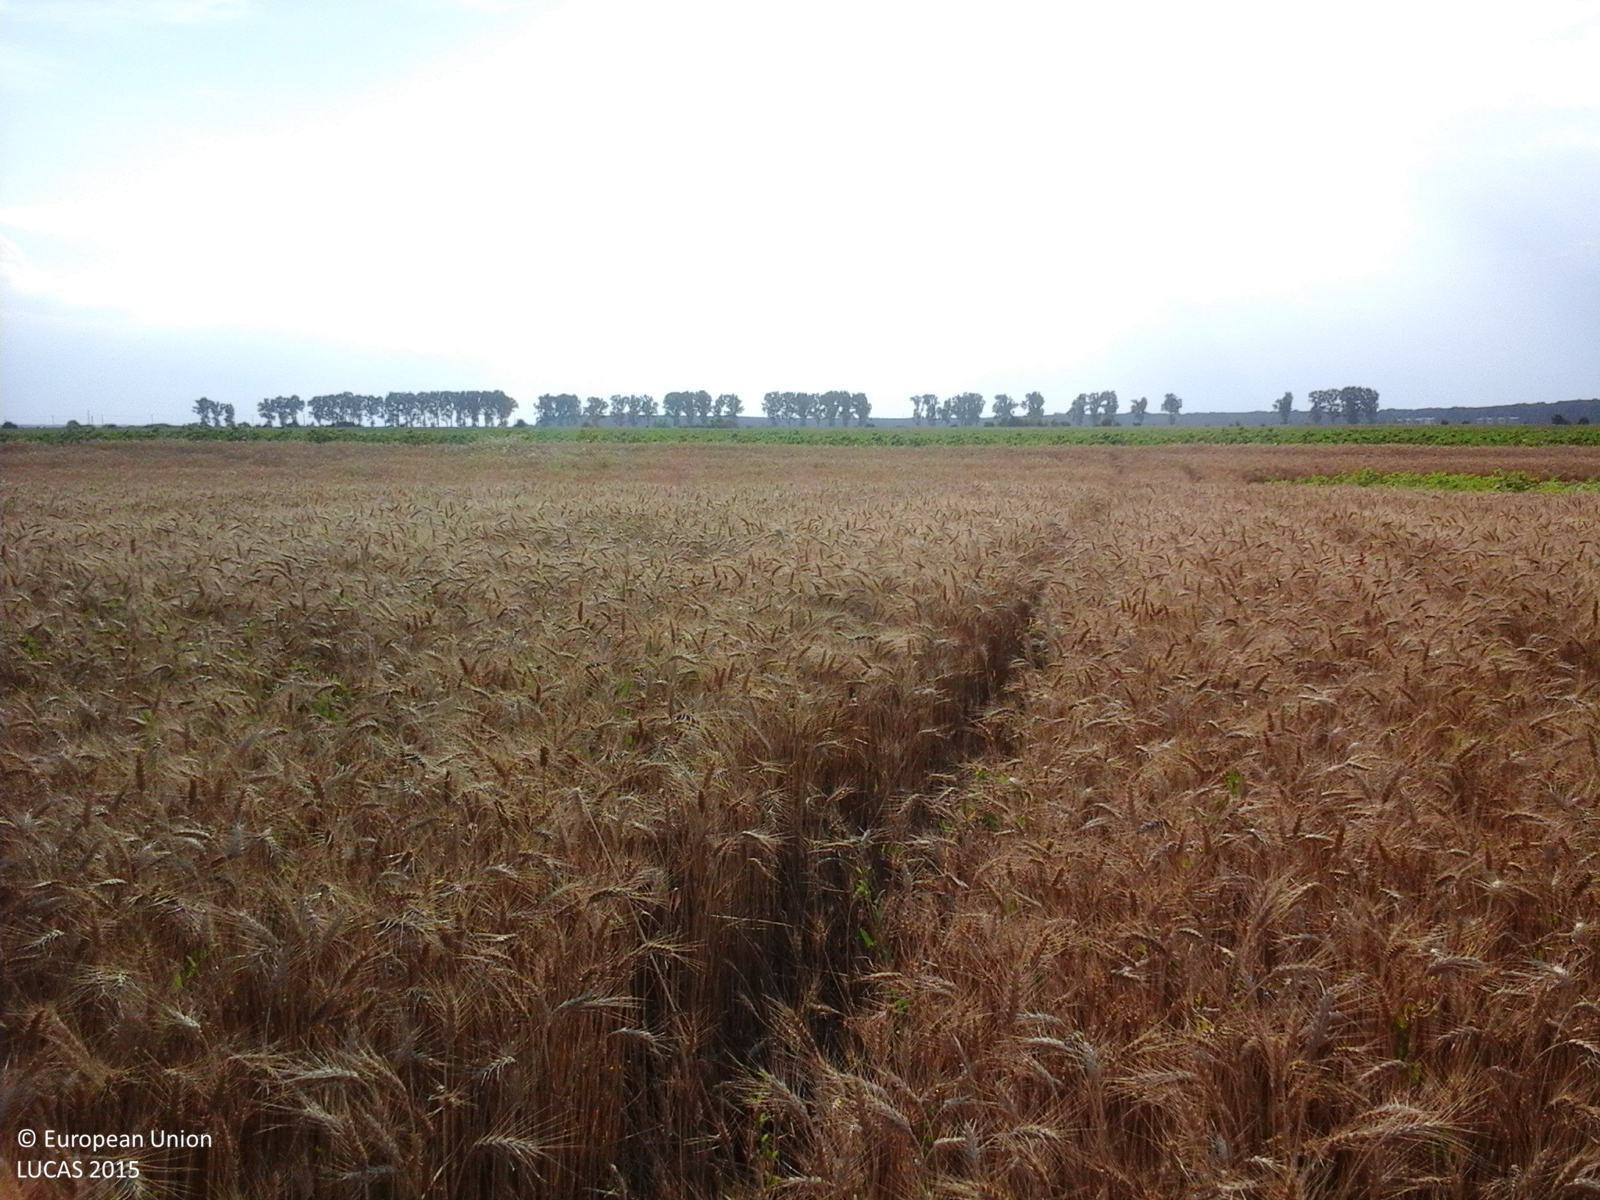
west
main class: Cropland
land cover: Common wheat
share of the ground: > 75 %
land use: Agriculture (excluding fallow land and kitchen gardens)
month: June
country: RO
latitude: 44.5671
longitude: 26.2394
